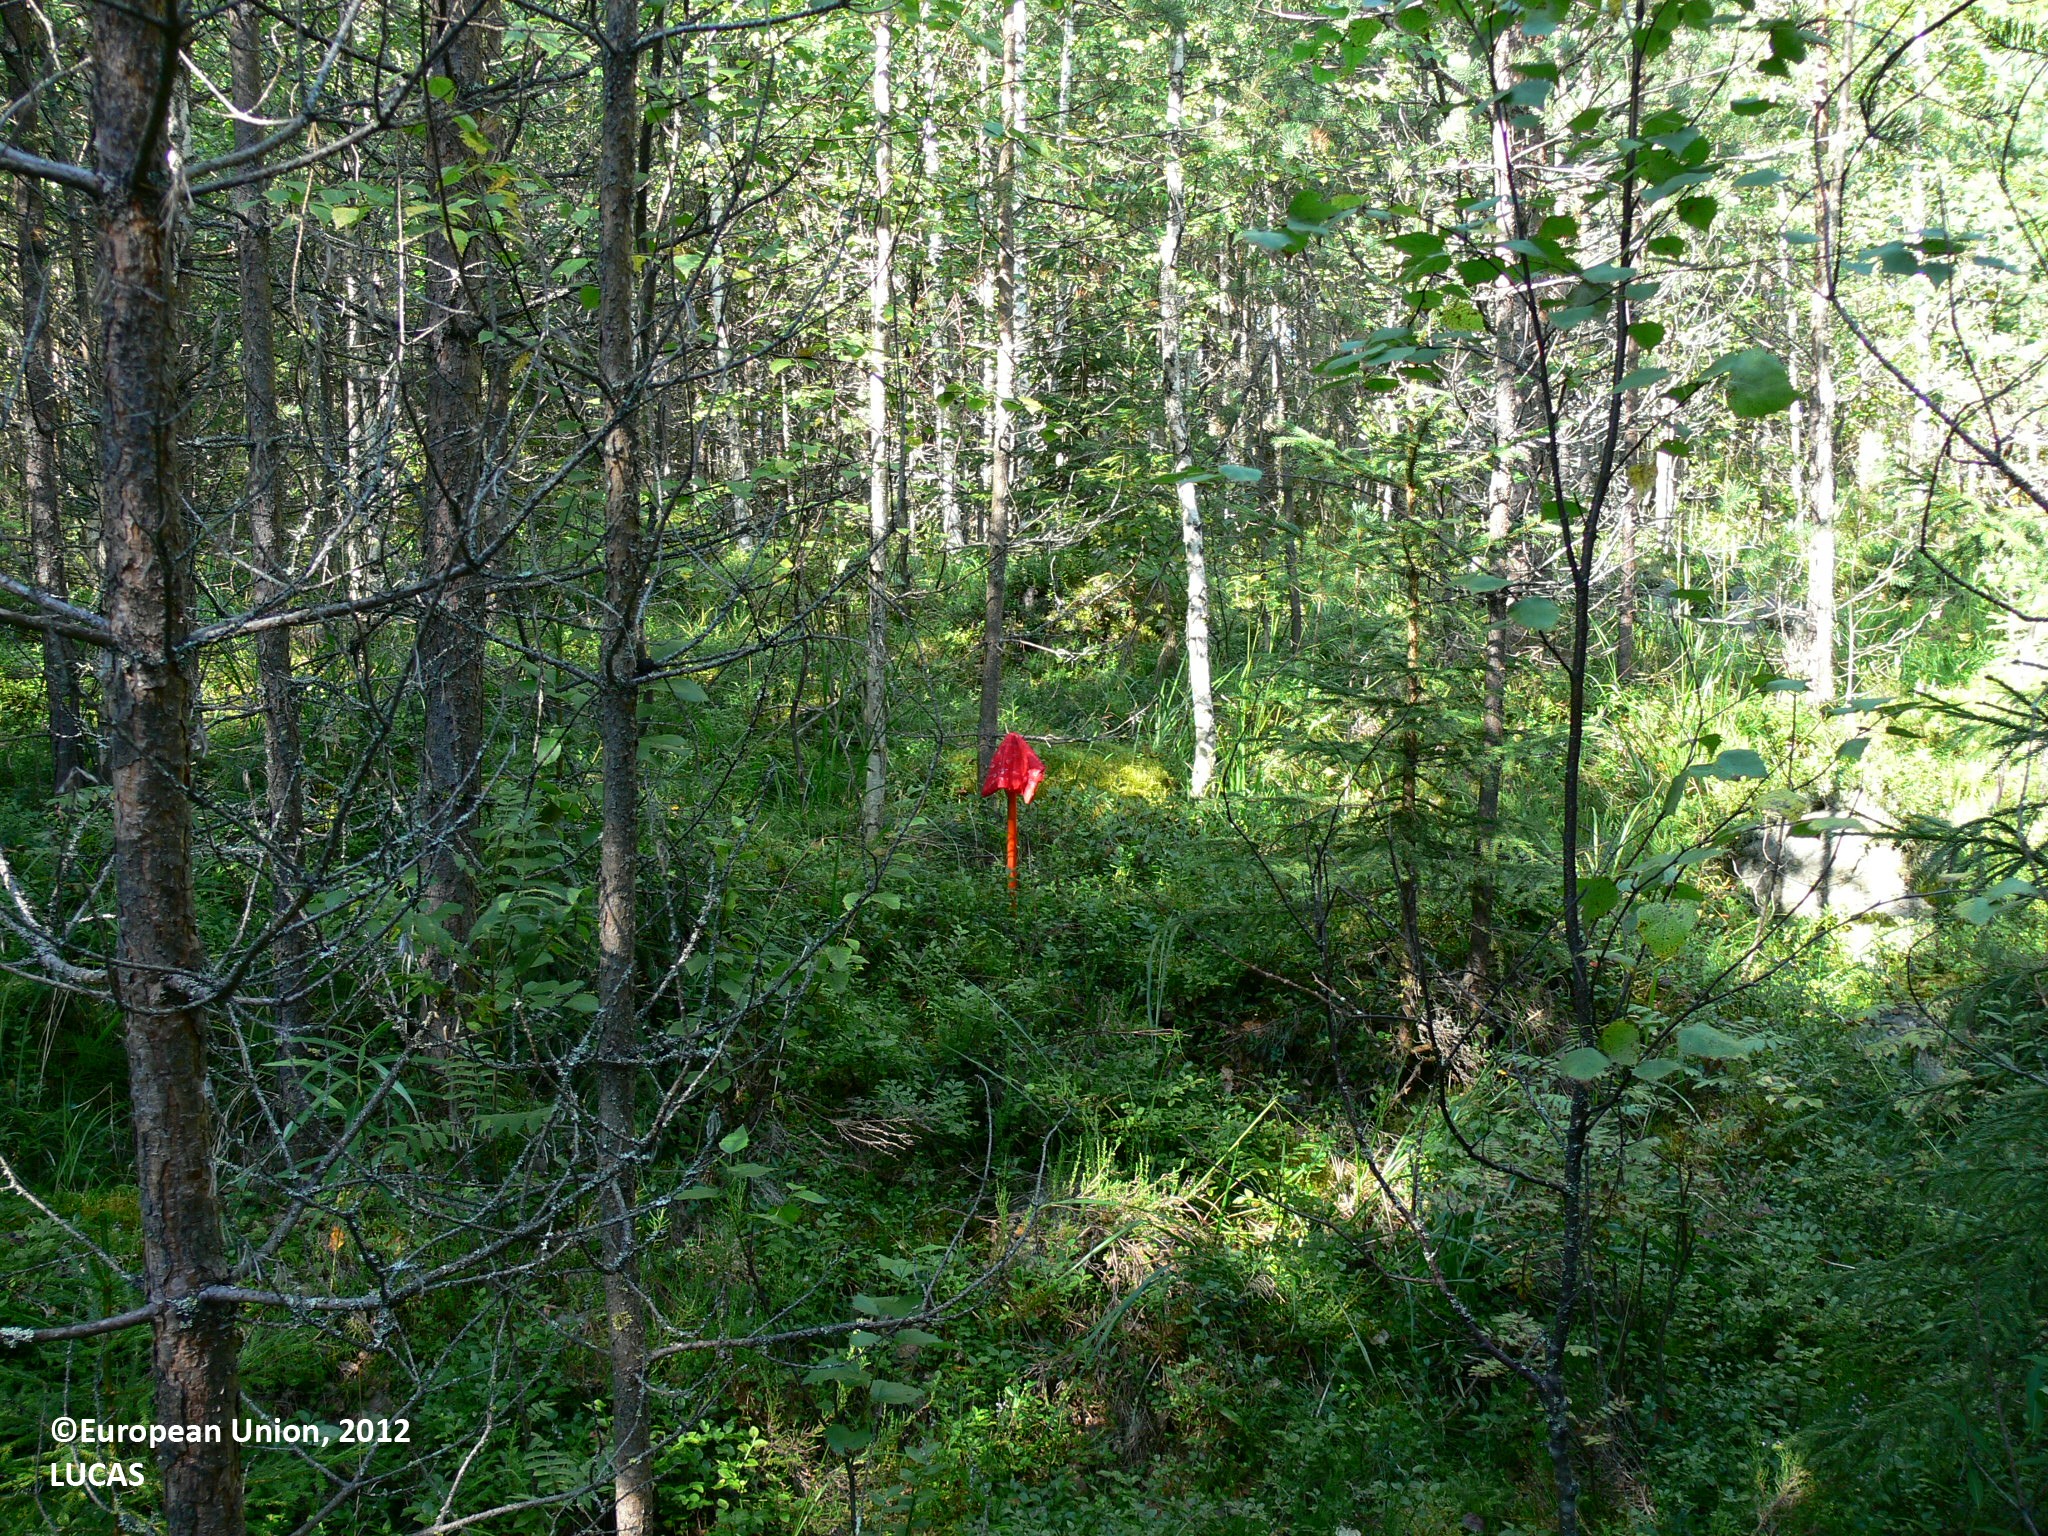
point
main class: Woodland
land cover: Pine dominated mixed woodland
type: boreal forest
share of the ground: 50 - 75 %
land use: Forestry
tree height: > 5 m
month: August
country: FI
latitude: 63.1560
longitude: 29.5885
